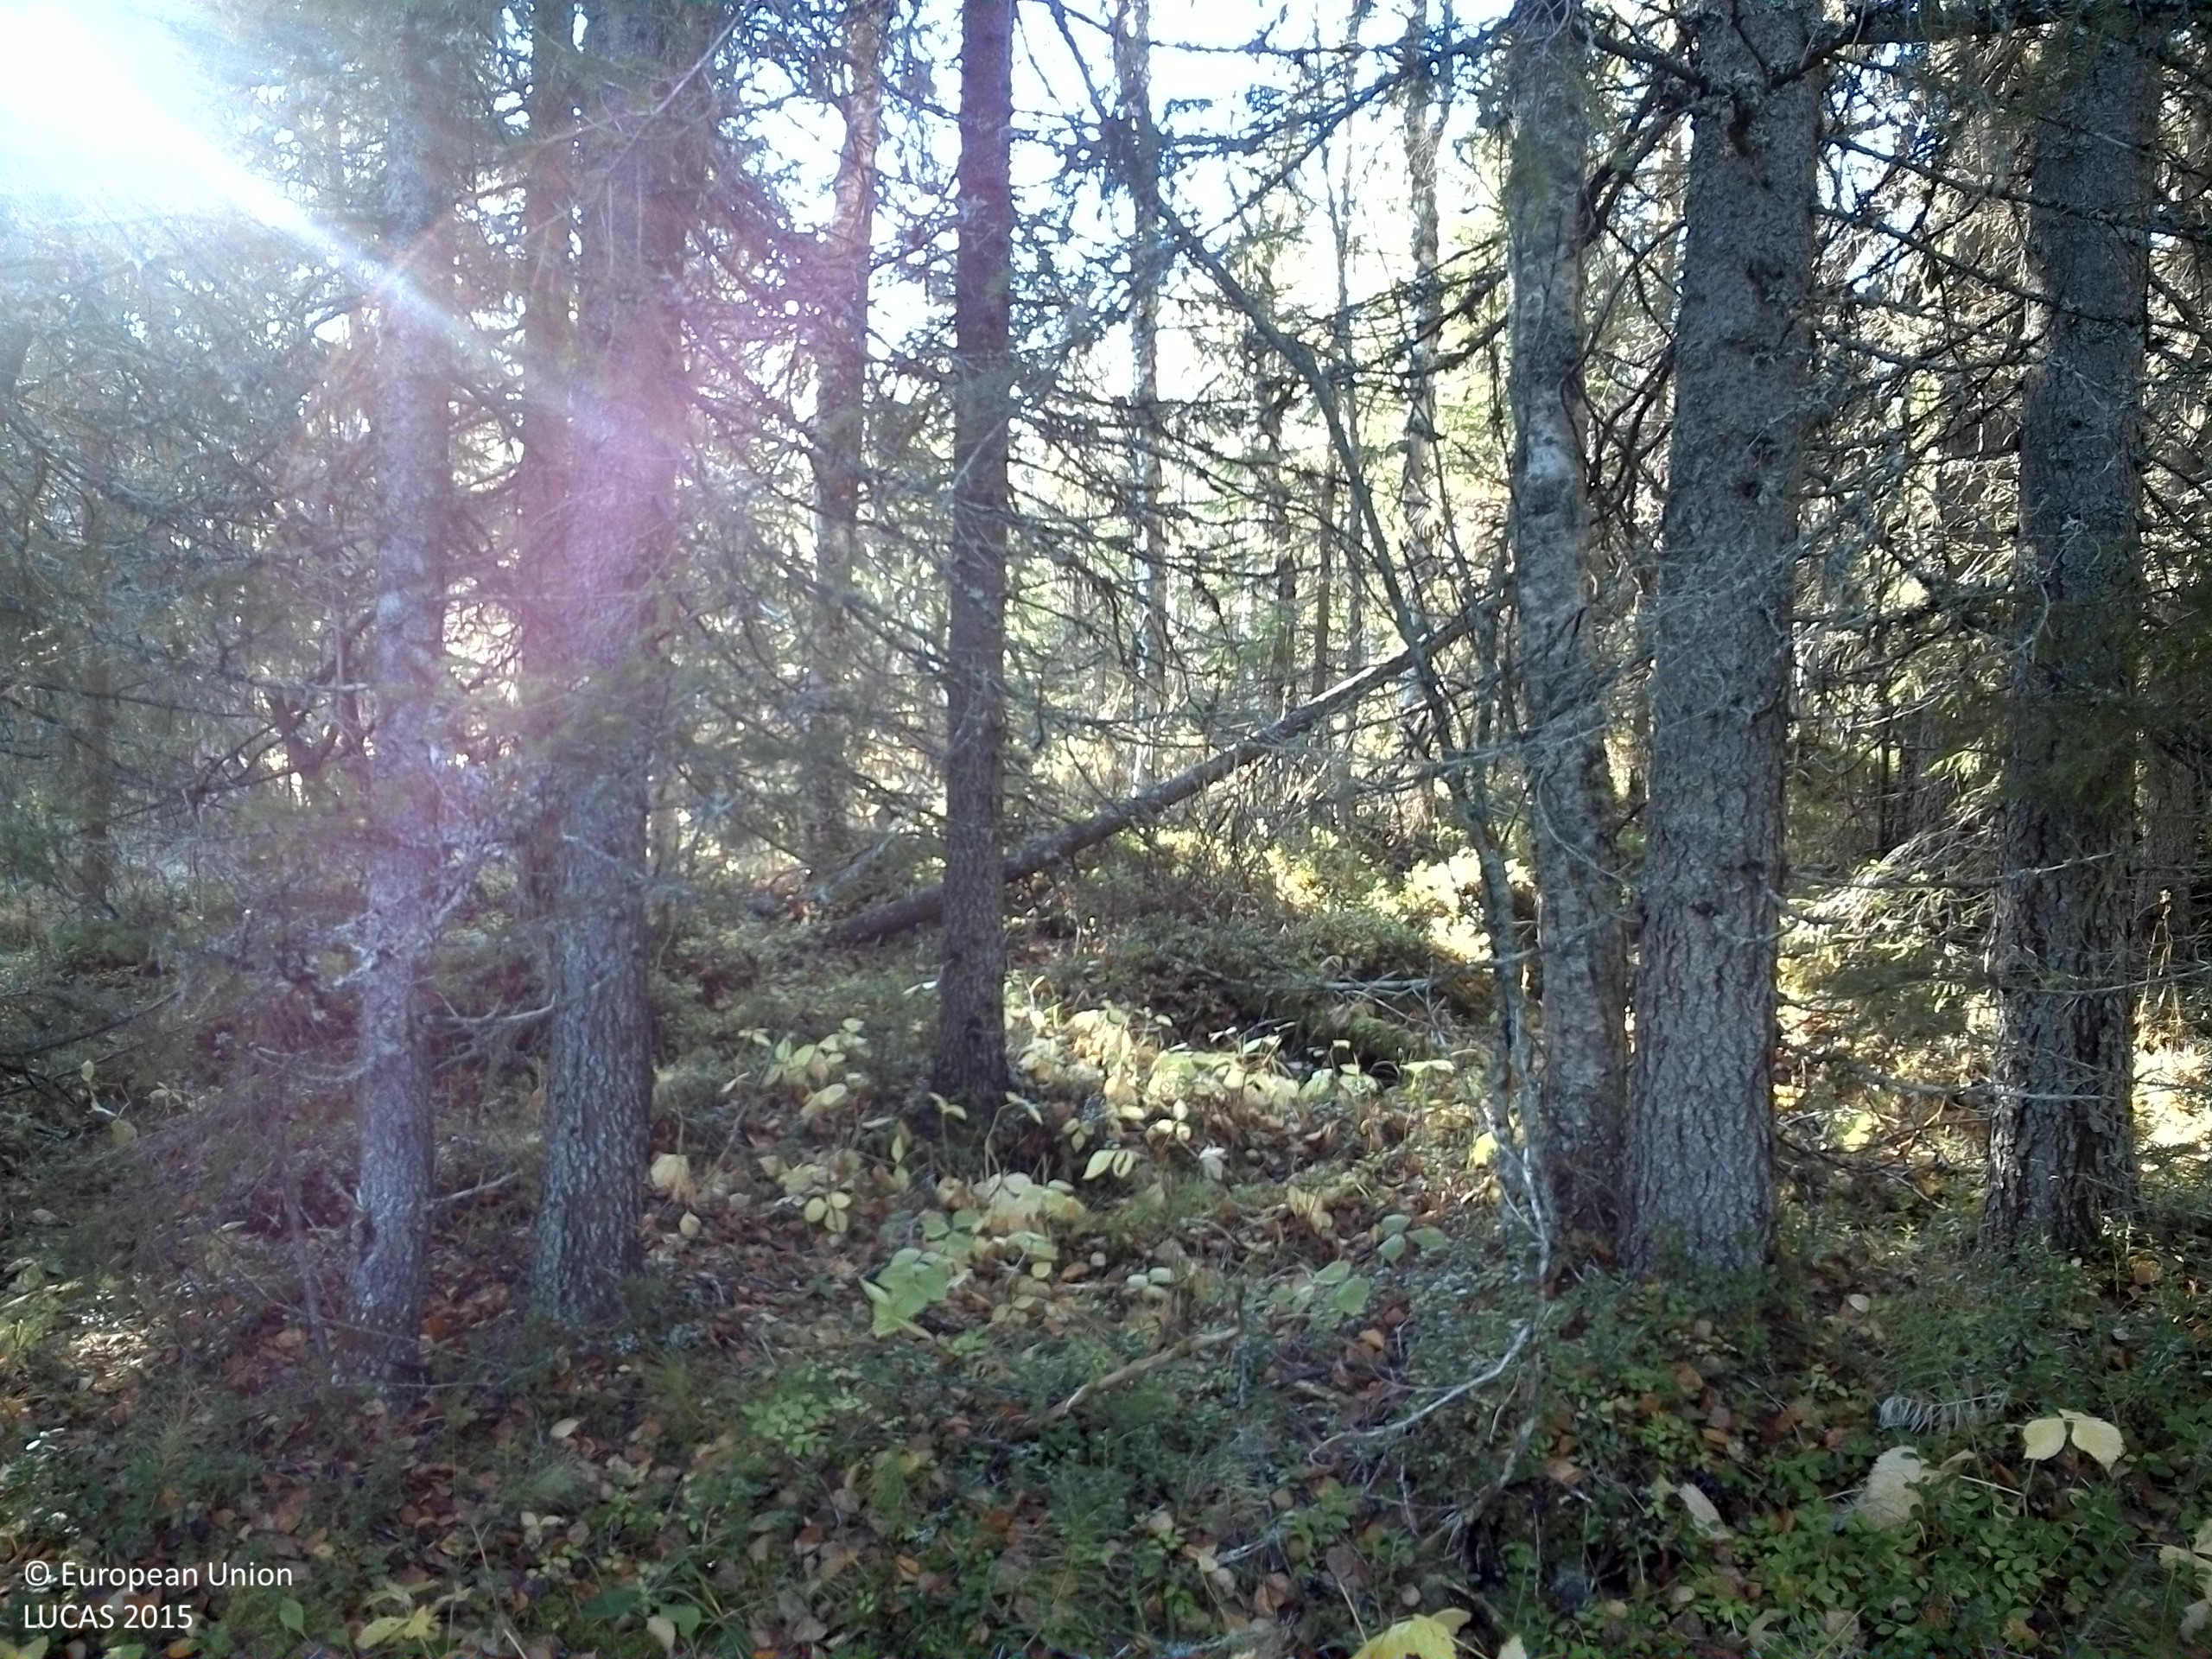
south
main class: Woodland
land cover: Spruce dominated mixed woodland
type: boreal forest
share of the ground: 50 - 75 %
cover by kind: coniferous forest trees 45 %, broadleaved forest trees 20 %, shrubs 15 %, herbaceous plants 10 %, lichens and mosses 10 %
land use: Forestry
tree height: > 5 m
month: October
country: SE
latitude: 64.4830
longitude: 15.5252
